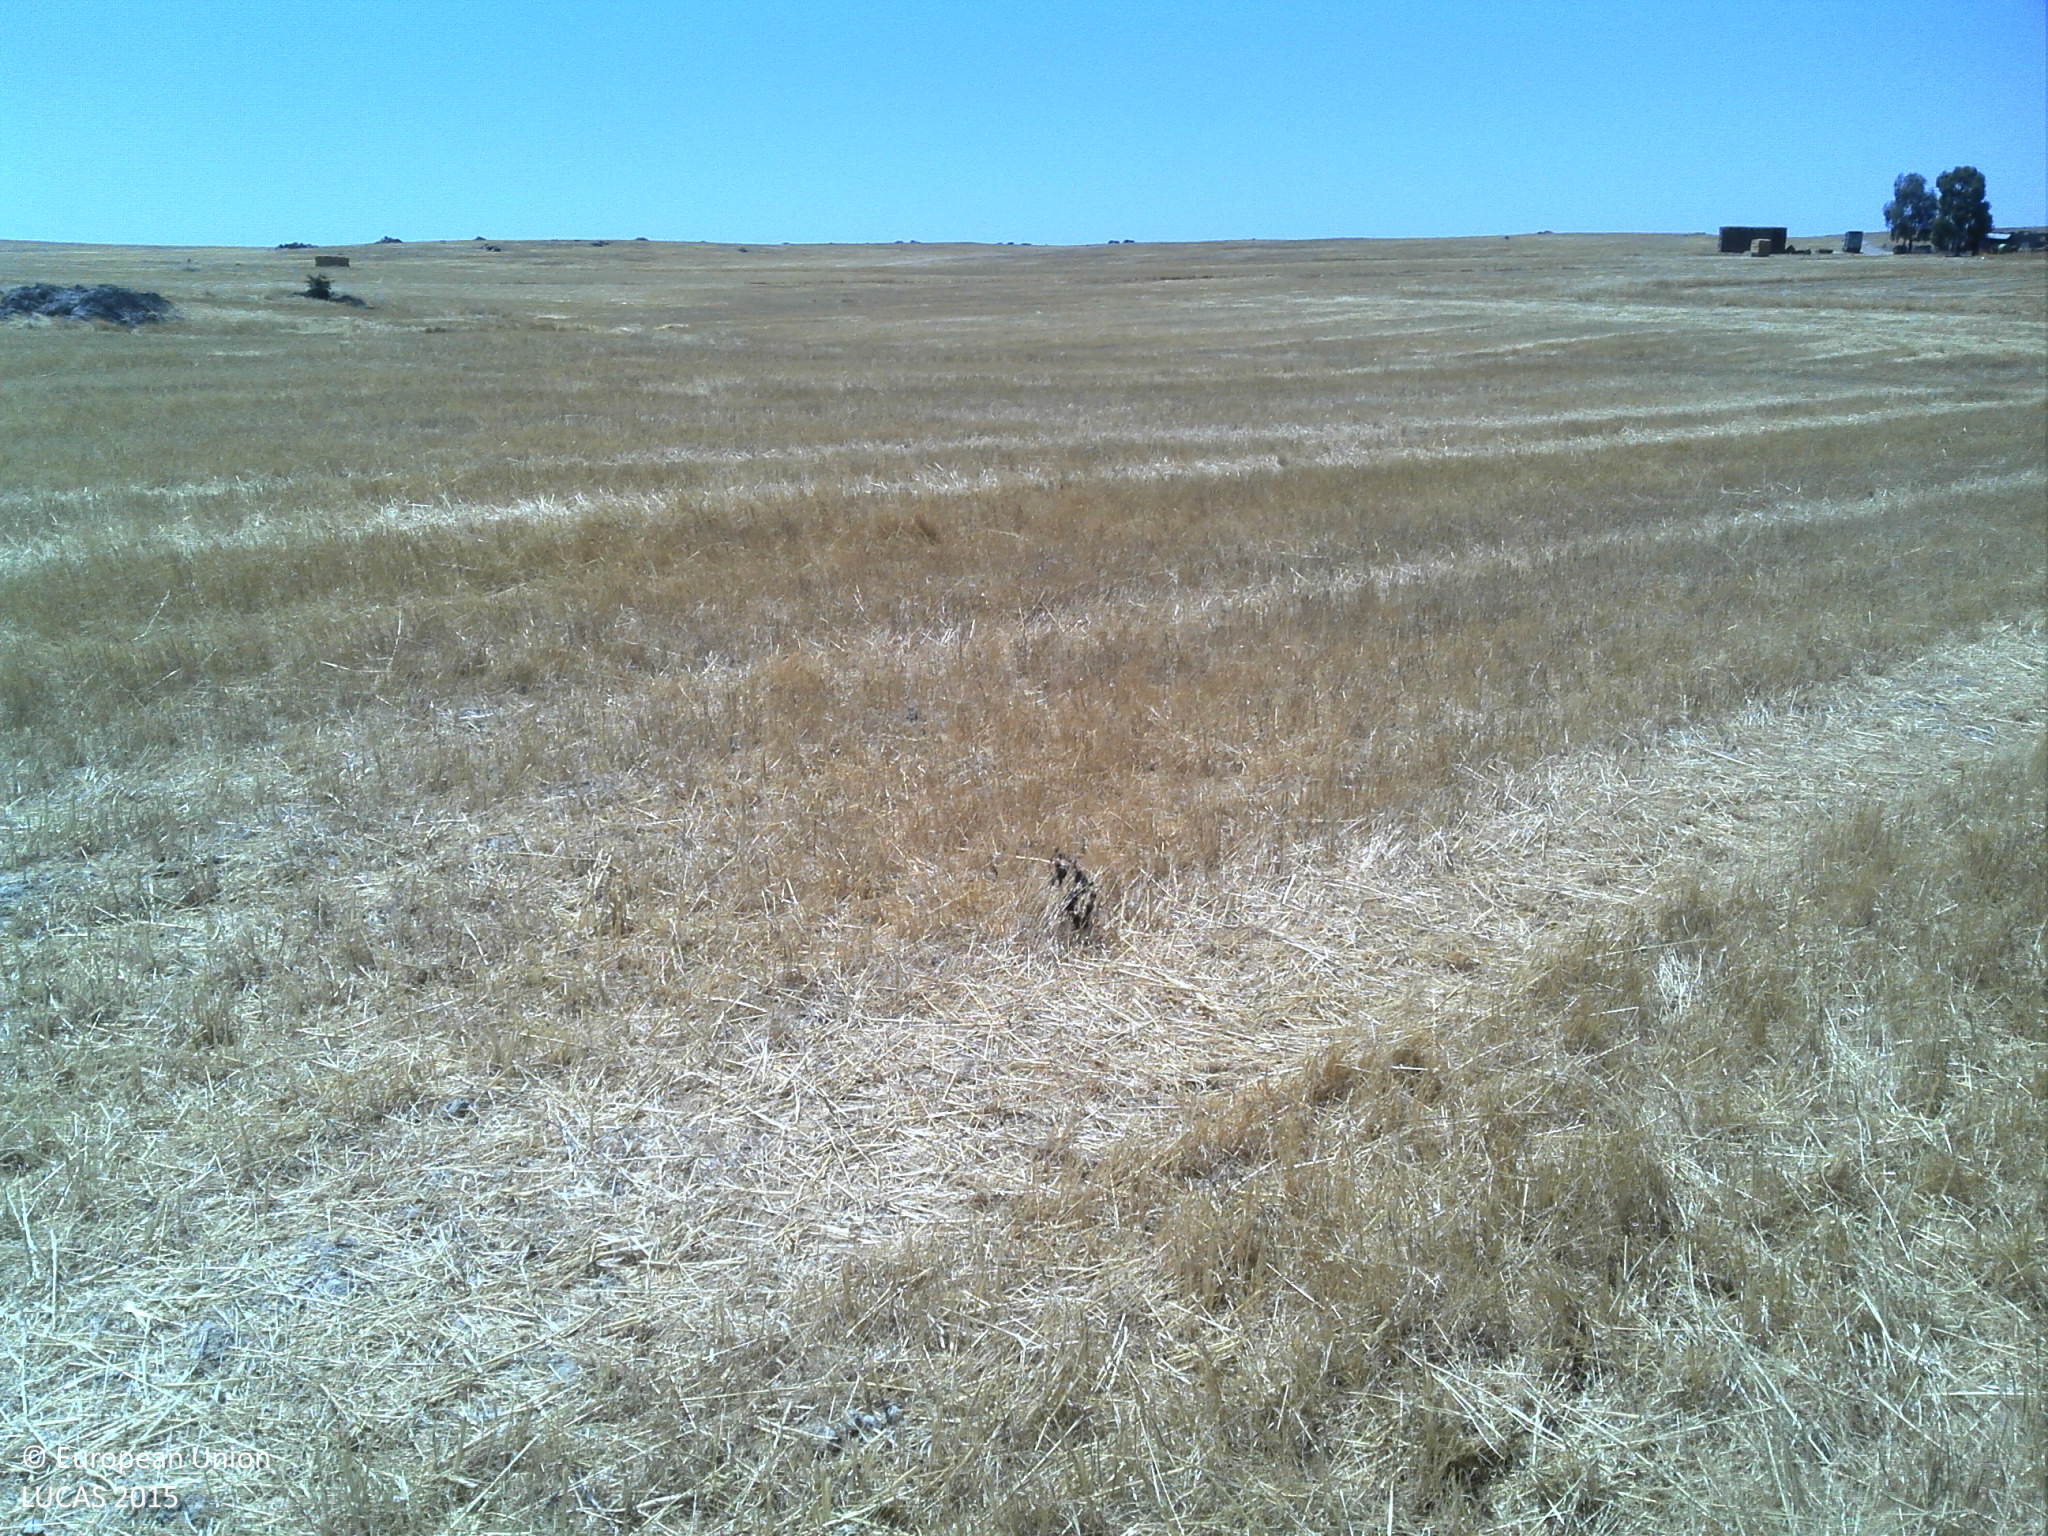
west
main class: Cropland
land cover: Oats
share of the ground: < 10 %
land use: Agriculture (excluding fallow land and kitchen gardens)
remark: Harvested field
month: July
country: PT
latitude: 37.7026
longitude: -7.8860
